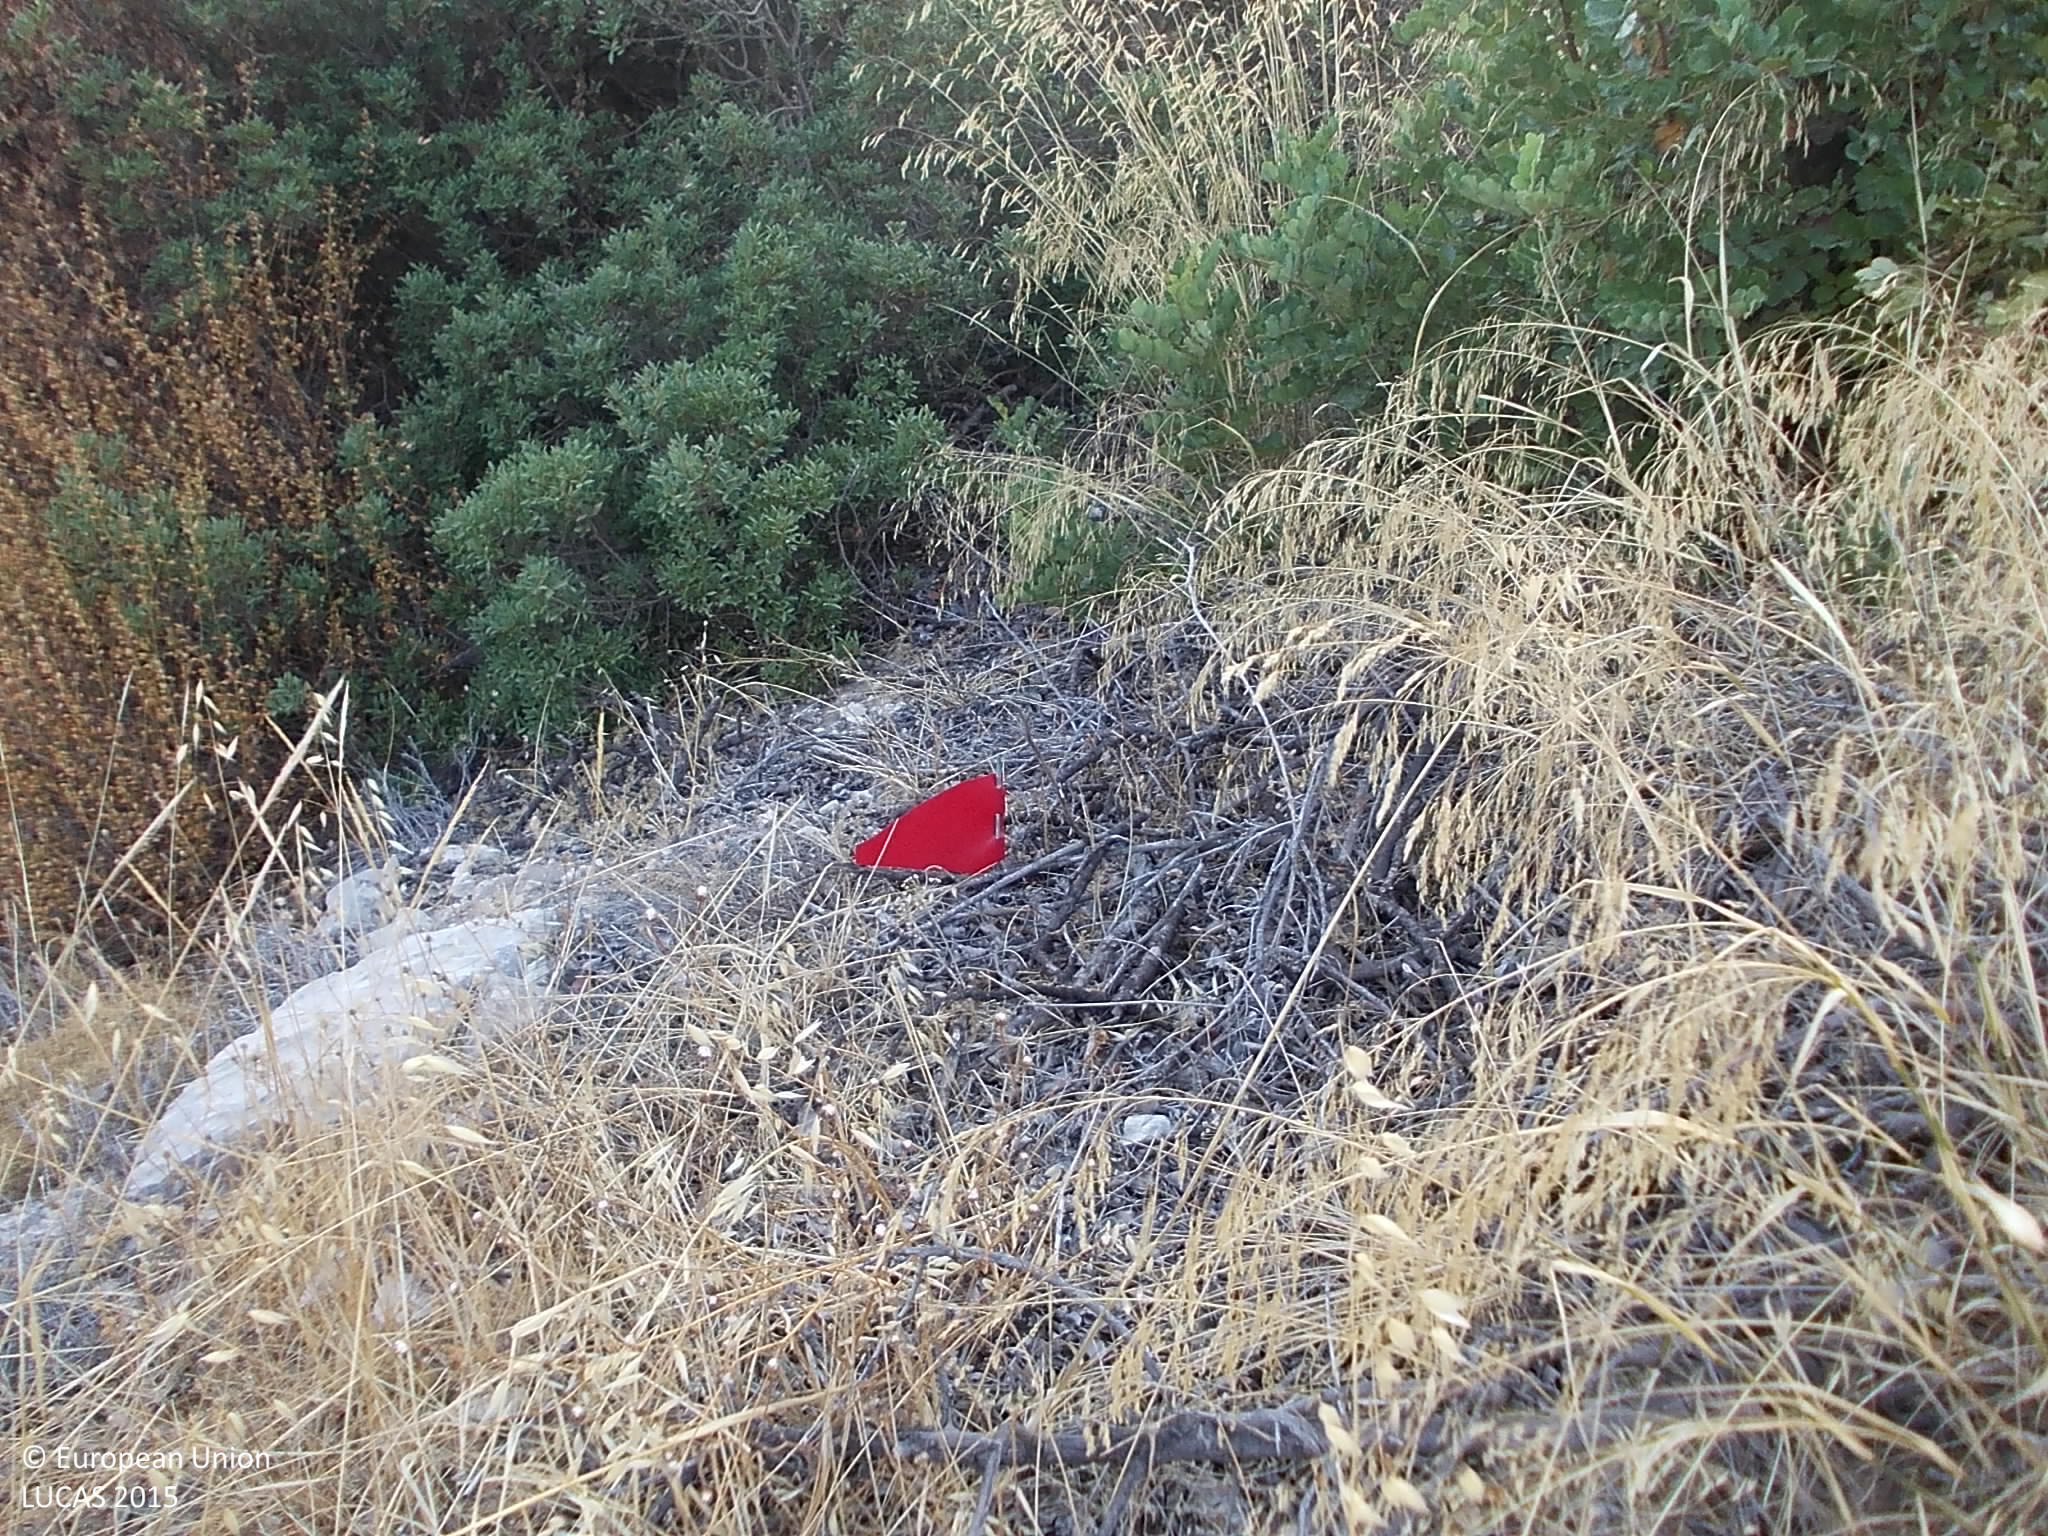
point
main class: Shrubland
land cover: Shrubland with sparse tree cover
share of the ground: > 75 %
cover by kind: shrubs 75 %, herbaceous plants 15 %, broadleaved forest trees 5 %, consolidated bare surface 5 %
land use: Semi-natural and natural areas not in use
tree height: < 5 m
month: August
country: CY
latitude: 34.7716
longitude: 33.0140
